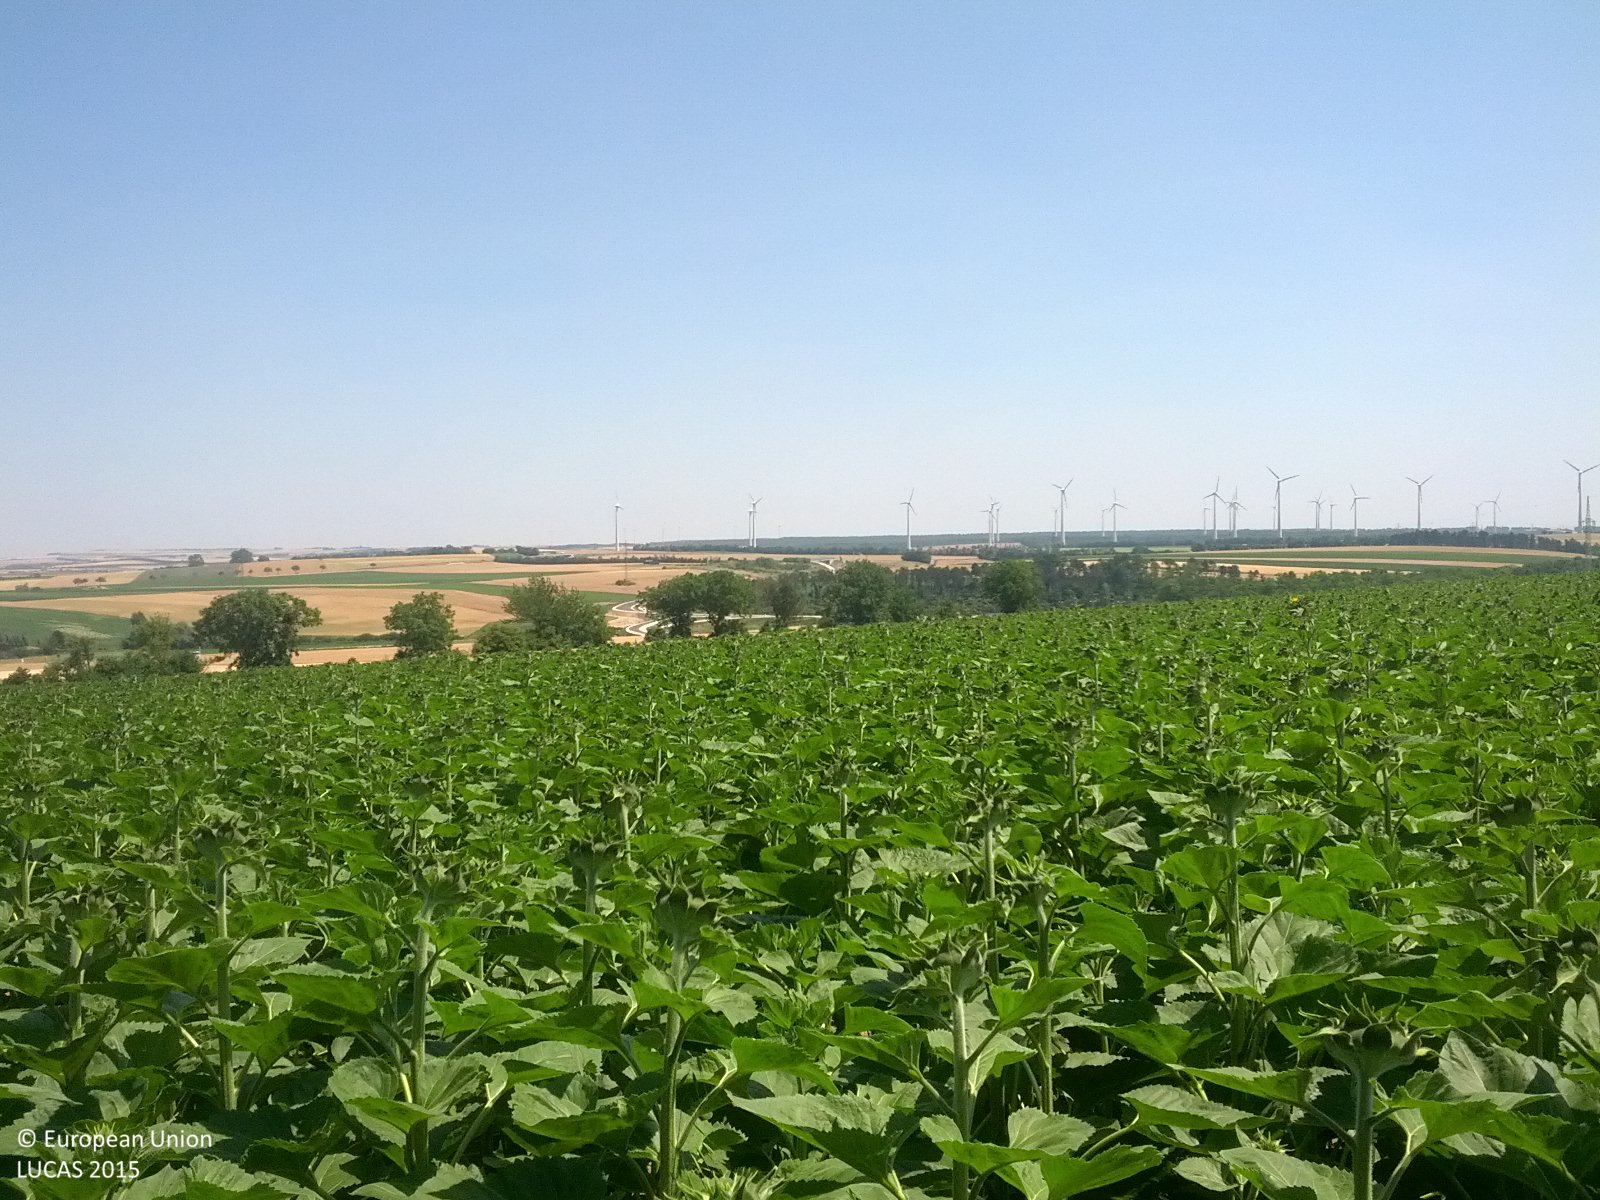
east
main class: Cropland
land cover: Sunflower
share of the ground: > 75 %
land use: Agriculture (excluding fallow land and kitchen gardens)
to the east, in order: Sunflower; Barley; Abandoned hedges; Tracks; Grass margins; Barley; Common wheat
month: July
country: AT
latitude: 48.5506
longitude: 16.5768
